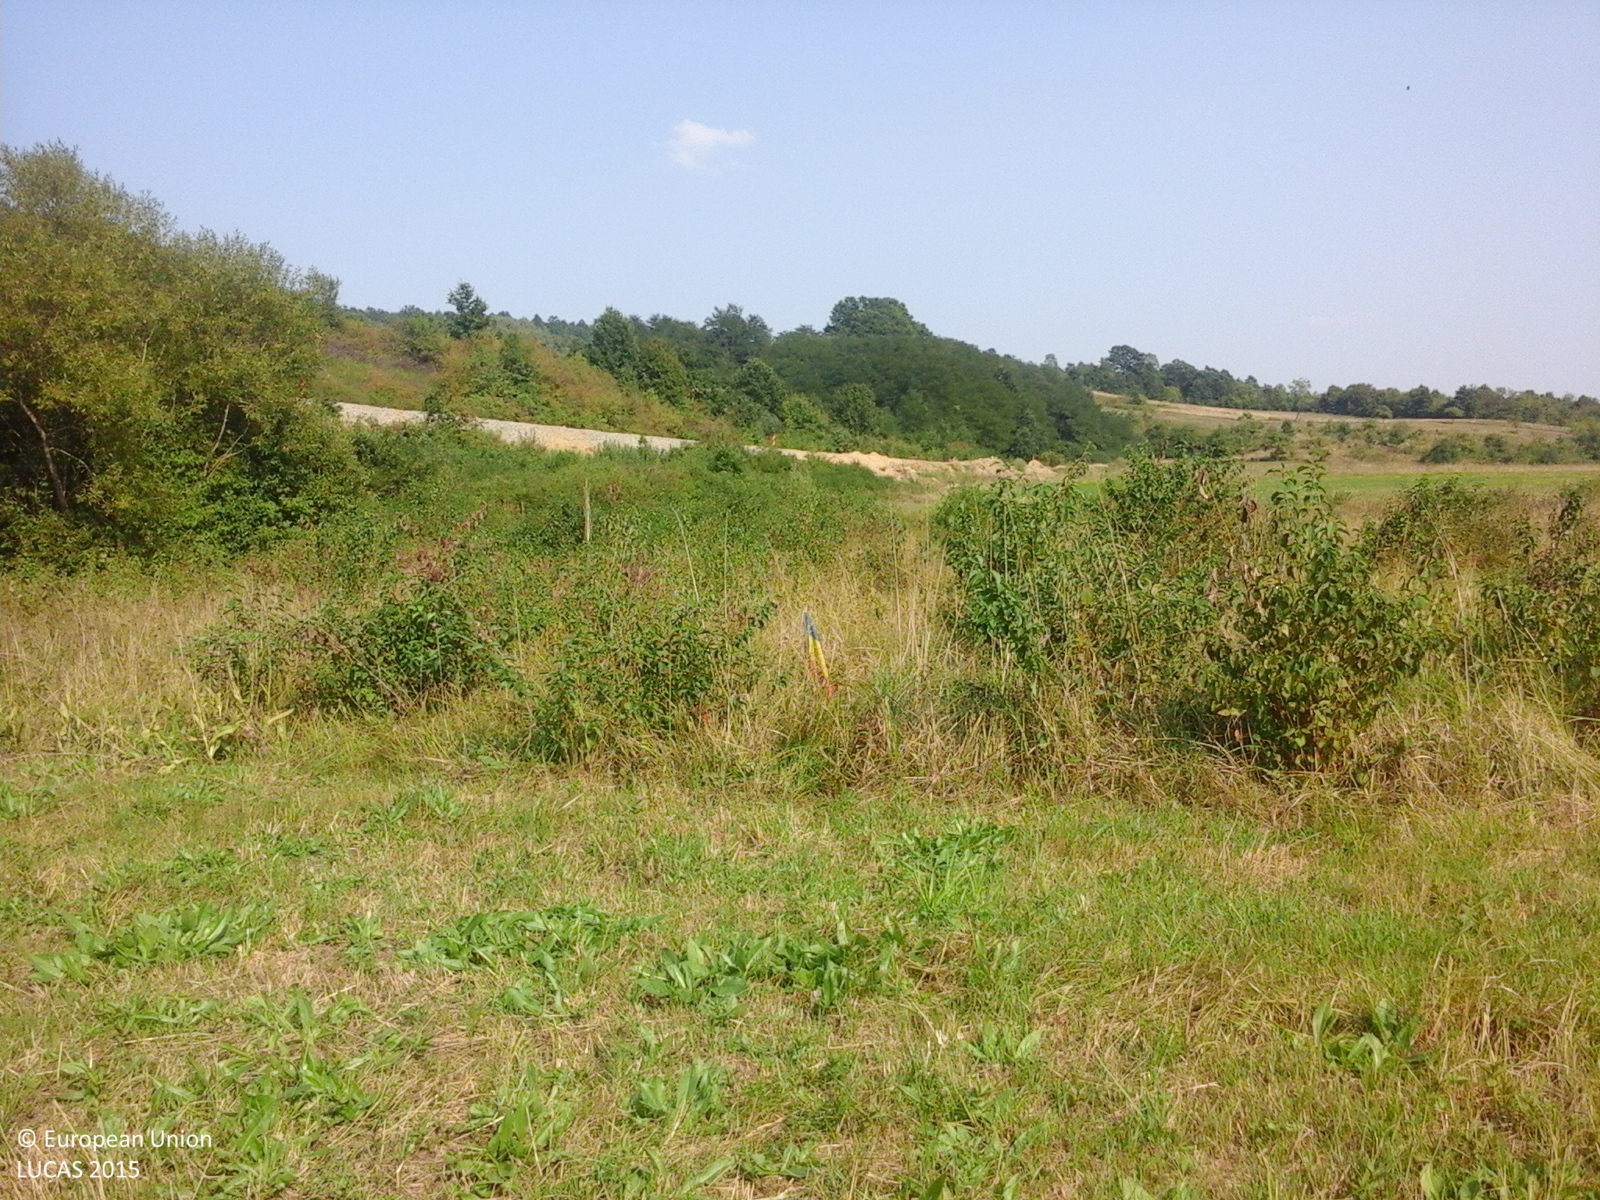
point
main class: Grassland
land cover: Spontaneously vegetated surfaces
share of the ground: > 75 %
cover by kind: herbaceous plants 100 %
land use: Fallow land
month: August
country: RO
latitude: 46.2059
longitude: 22.5839
